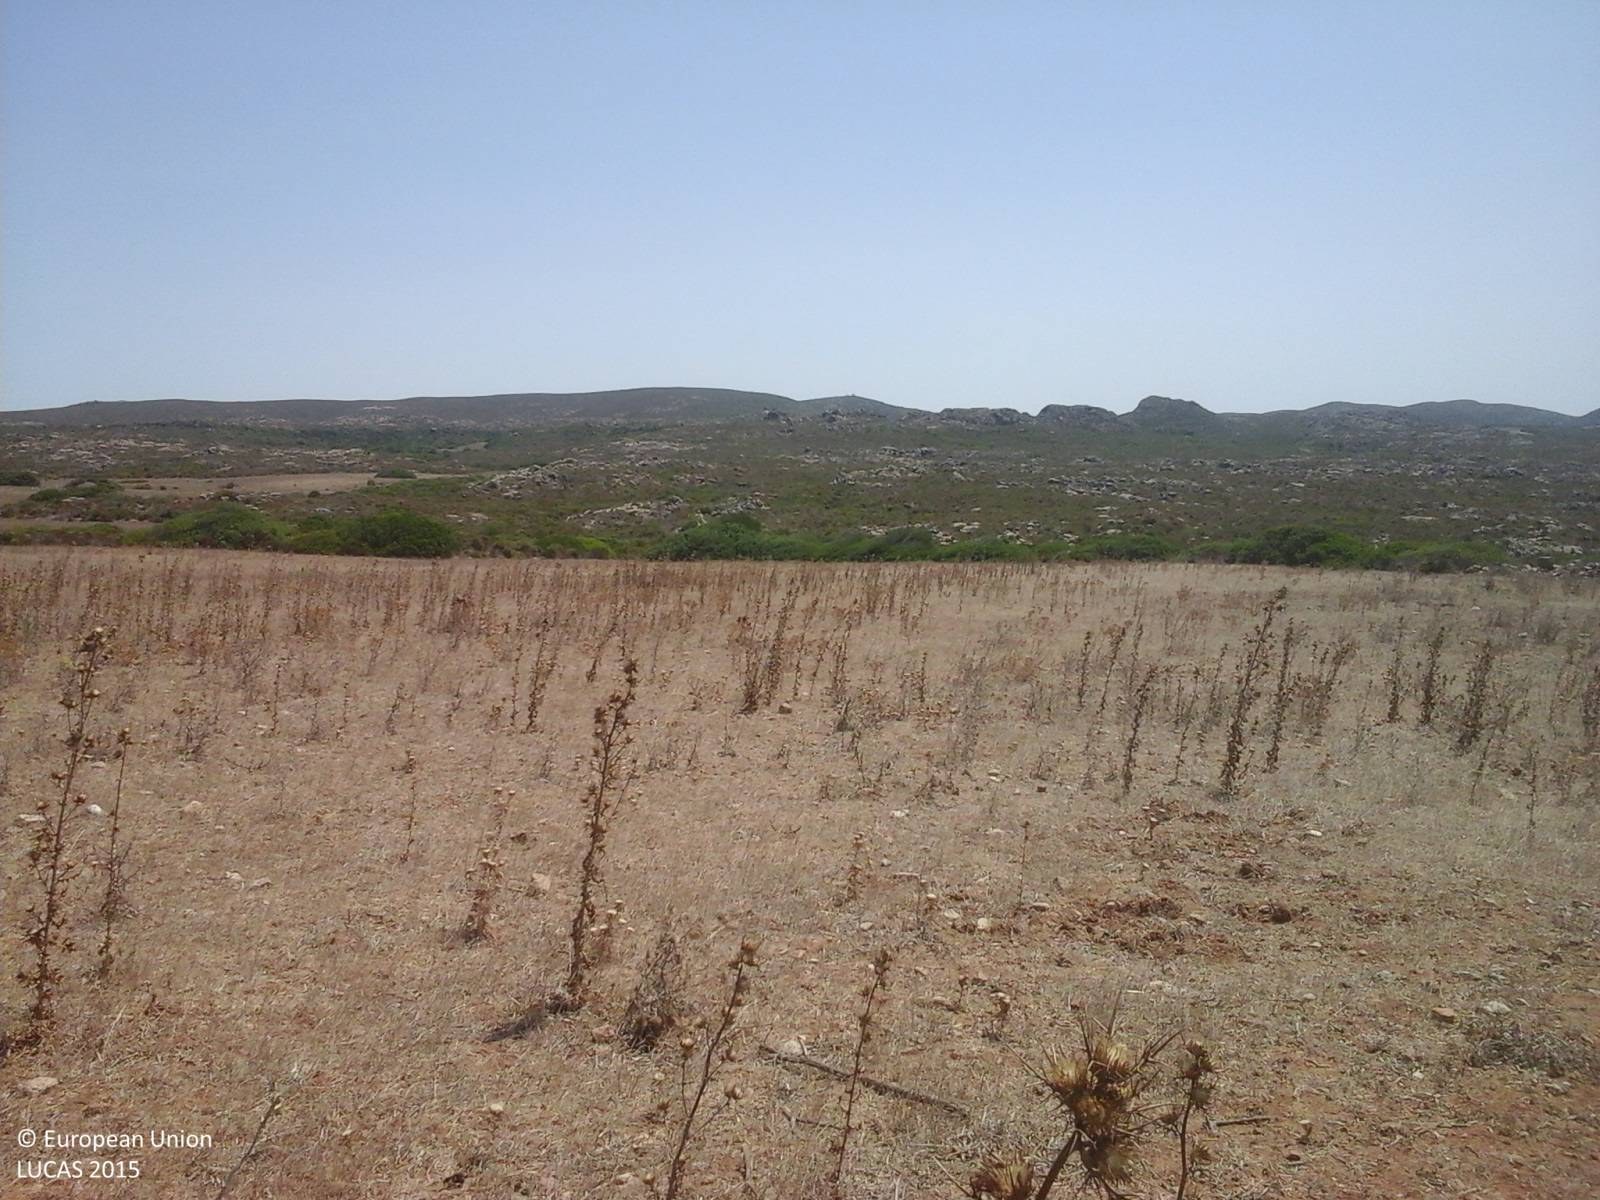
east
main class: Grassland
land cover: Spontaneously vegetated surfaces
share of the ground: > 75 %
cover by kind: herbaceous plants 85 %, unconsolidated bare surface 15 %
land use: Agriculture (excluding fallow land and kitchen gardens)
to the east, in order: Spontaneously vegetated surfaces; Tracks; Spontaneously vegetated surfaces; Shrubland without tree cover
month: July
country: IT
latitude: 39.0401
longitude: 8.3813
